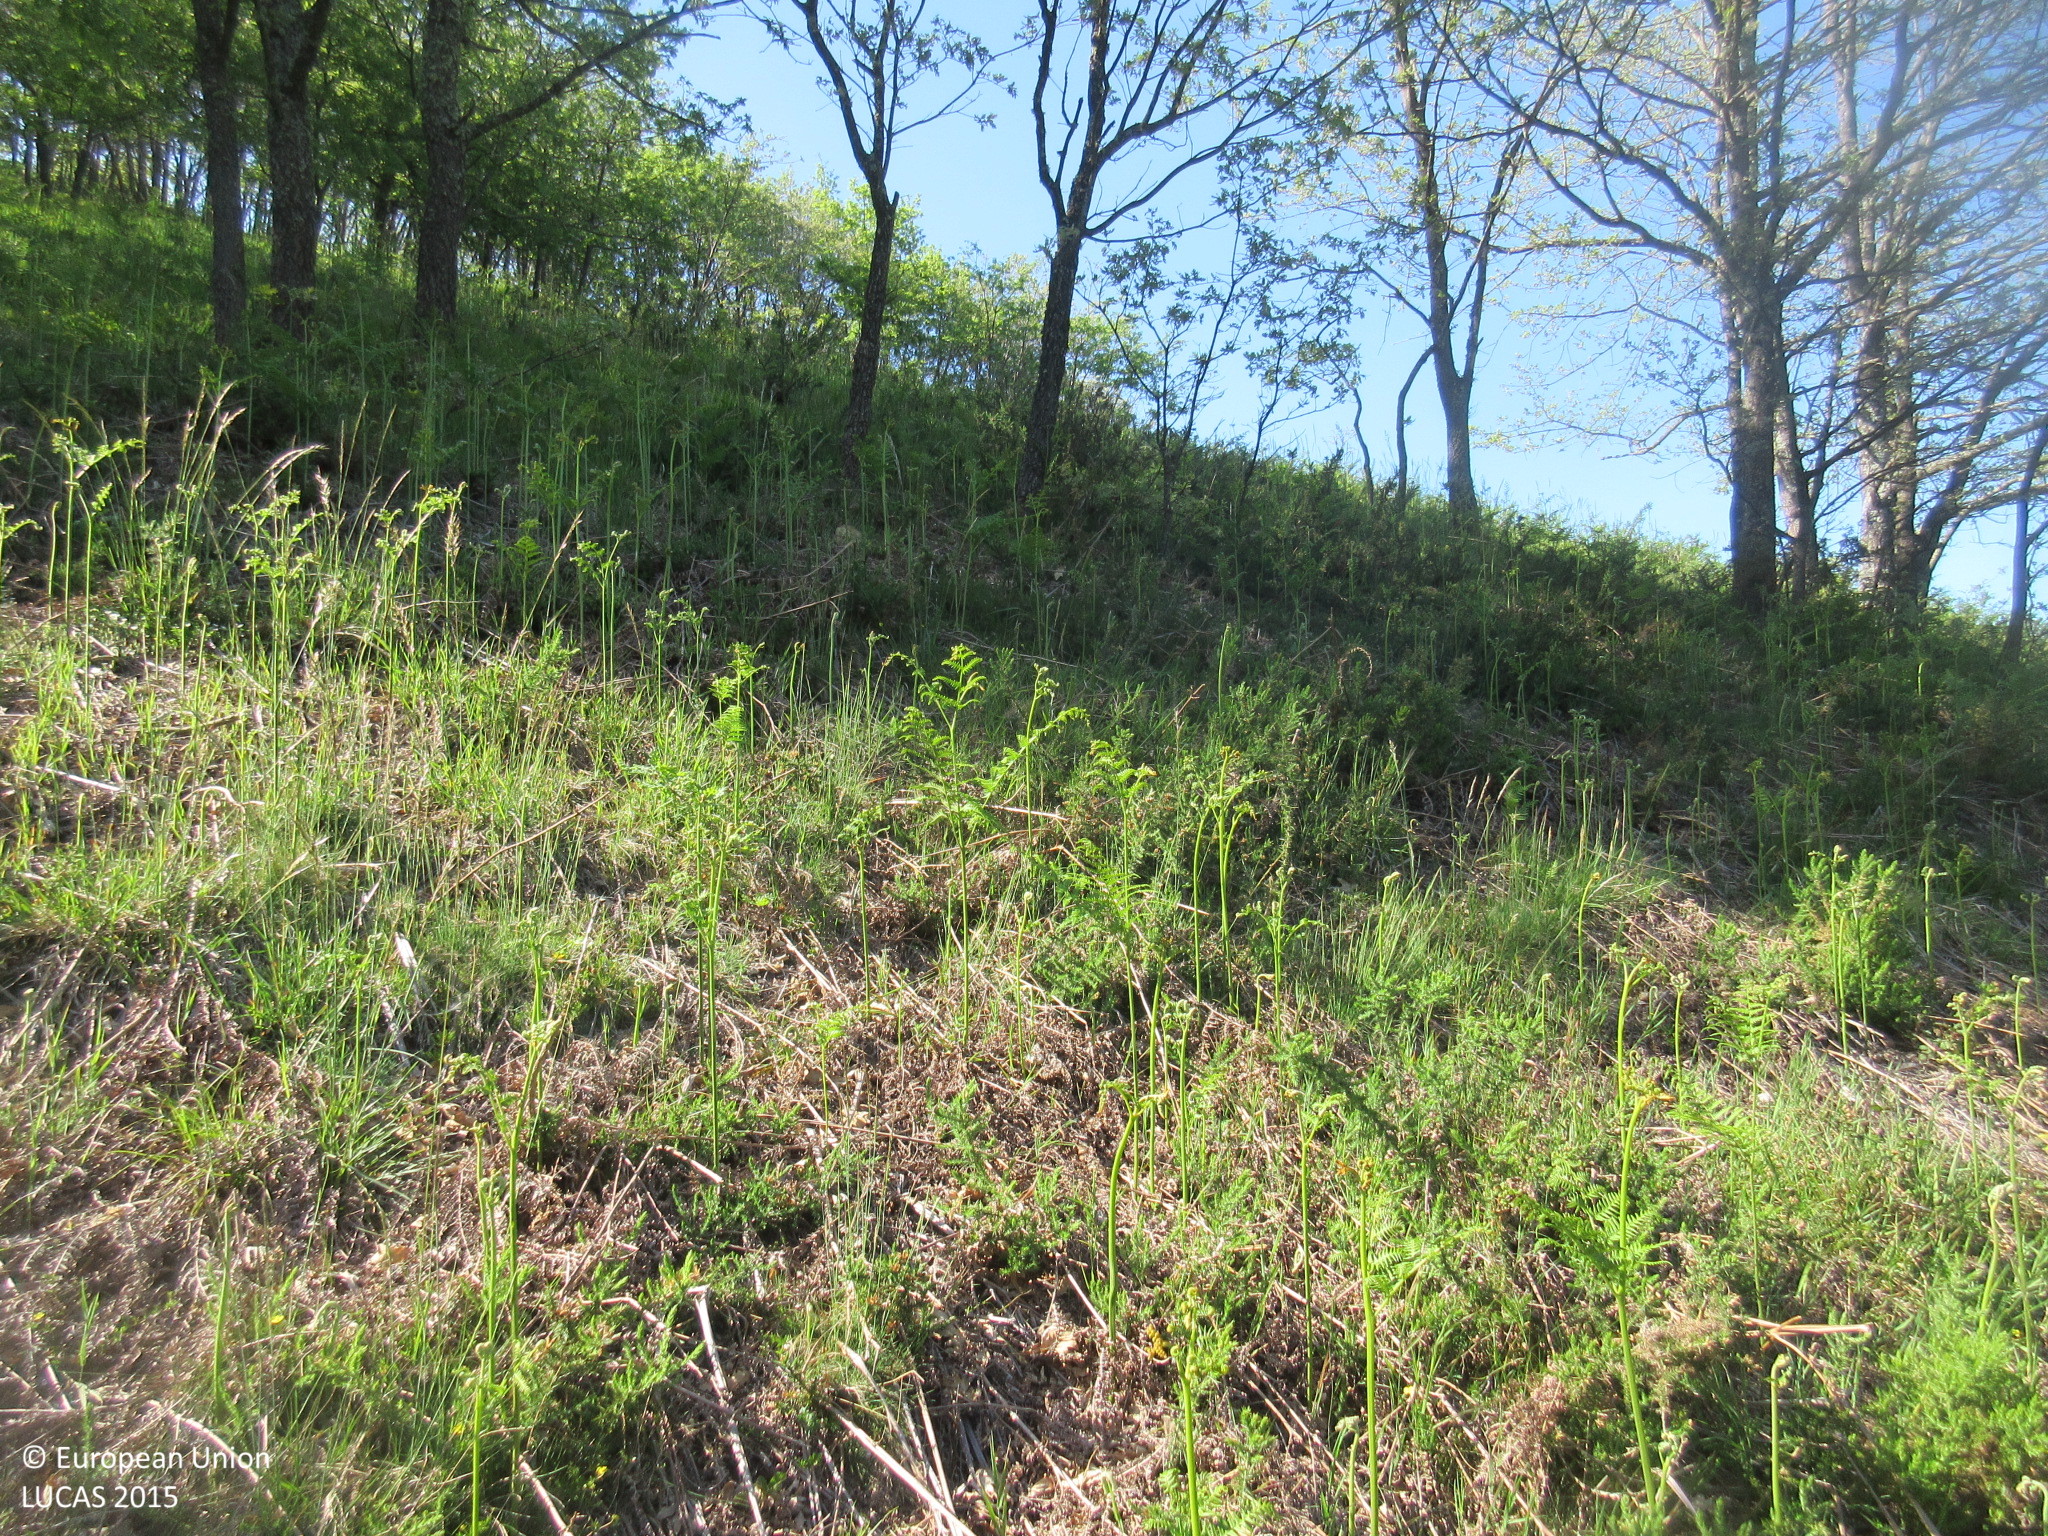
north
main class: Woodland
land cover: Broadleaved woodland
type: acidophilous oak and oak-birch forest
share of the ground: 50 - 75 %
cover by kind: broadleaved forest trees 60 %, shrubs 30 %, herbaceous plants 10 %
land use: Agriculture (excluding fallow land and kitchen gardens)
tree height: > 5 m
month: June
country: ES
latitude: 43.0994
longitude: -4.4190
